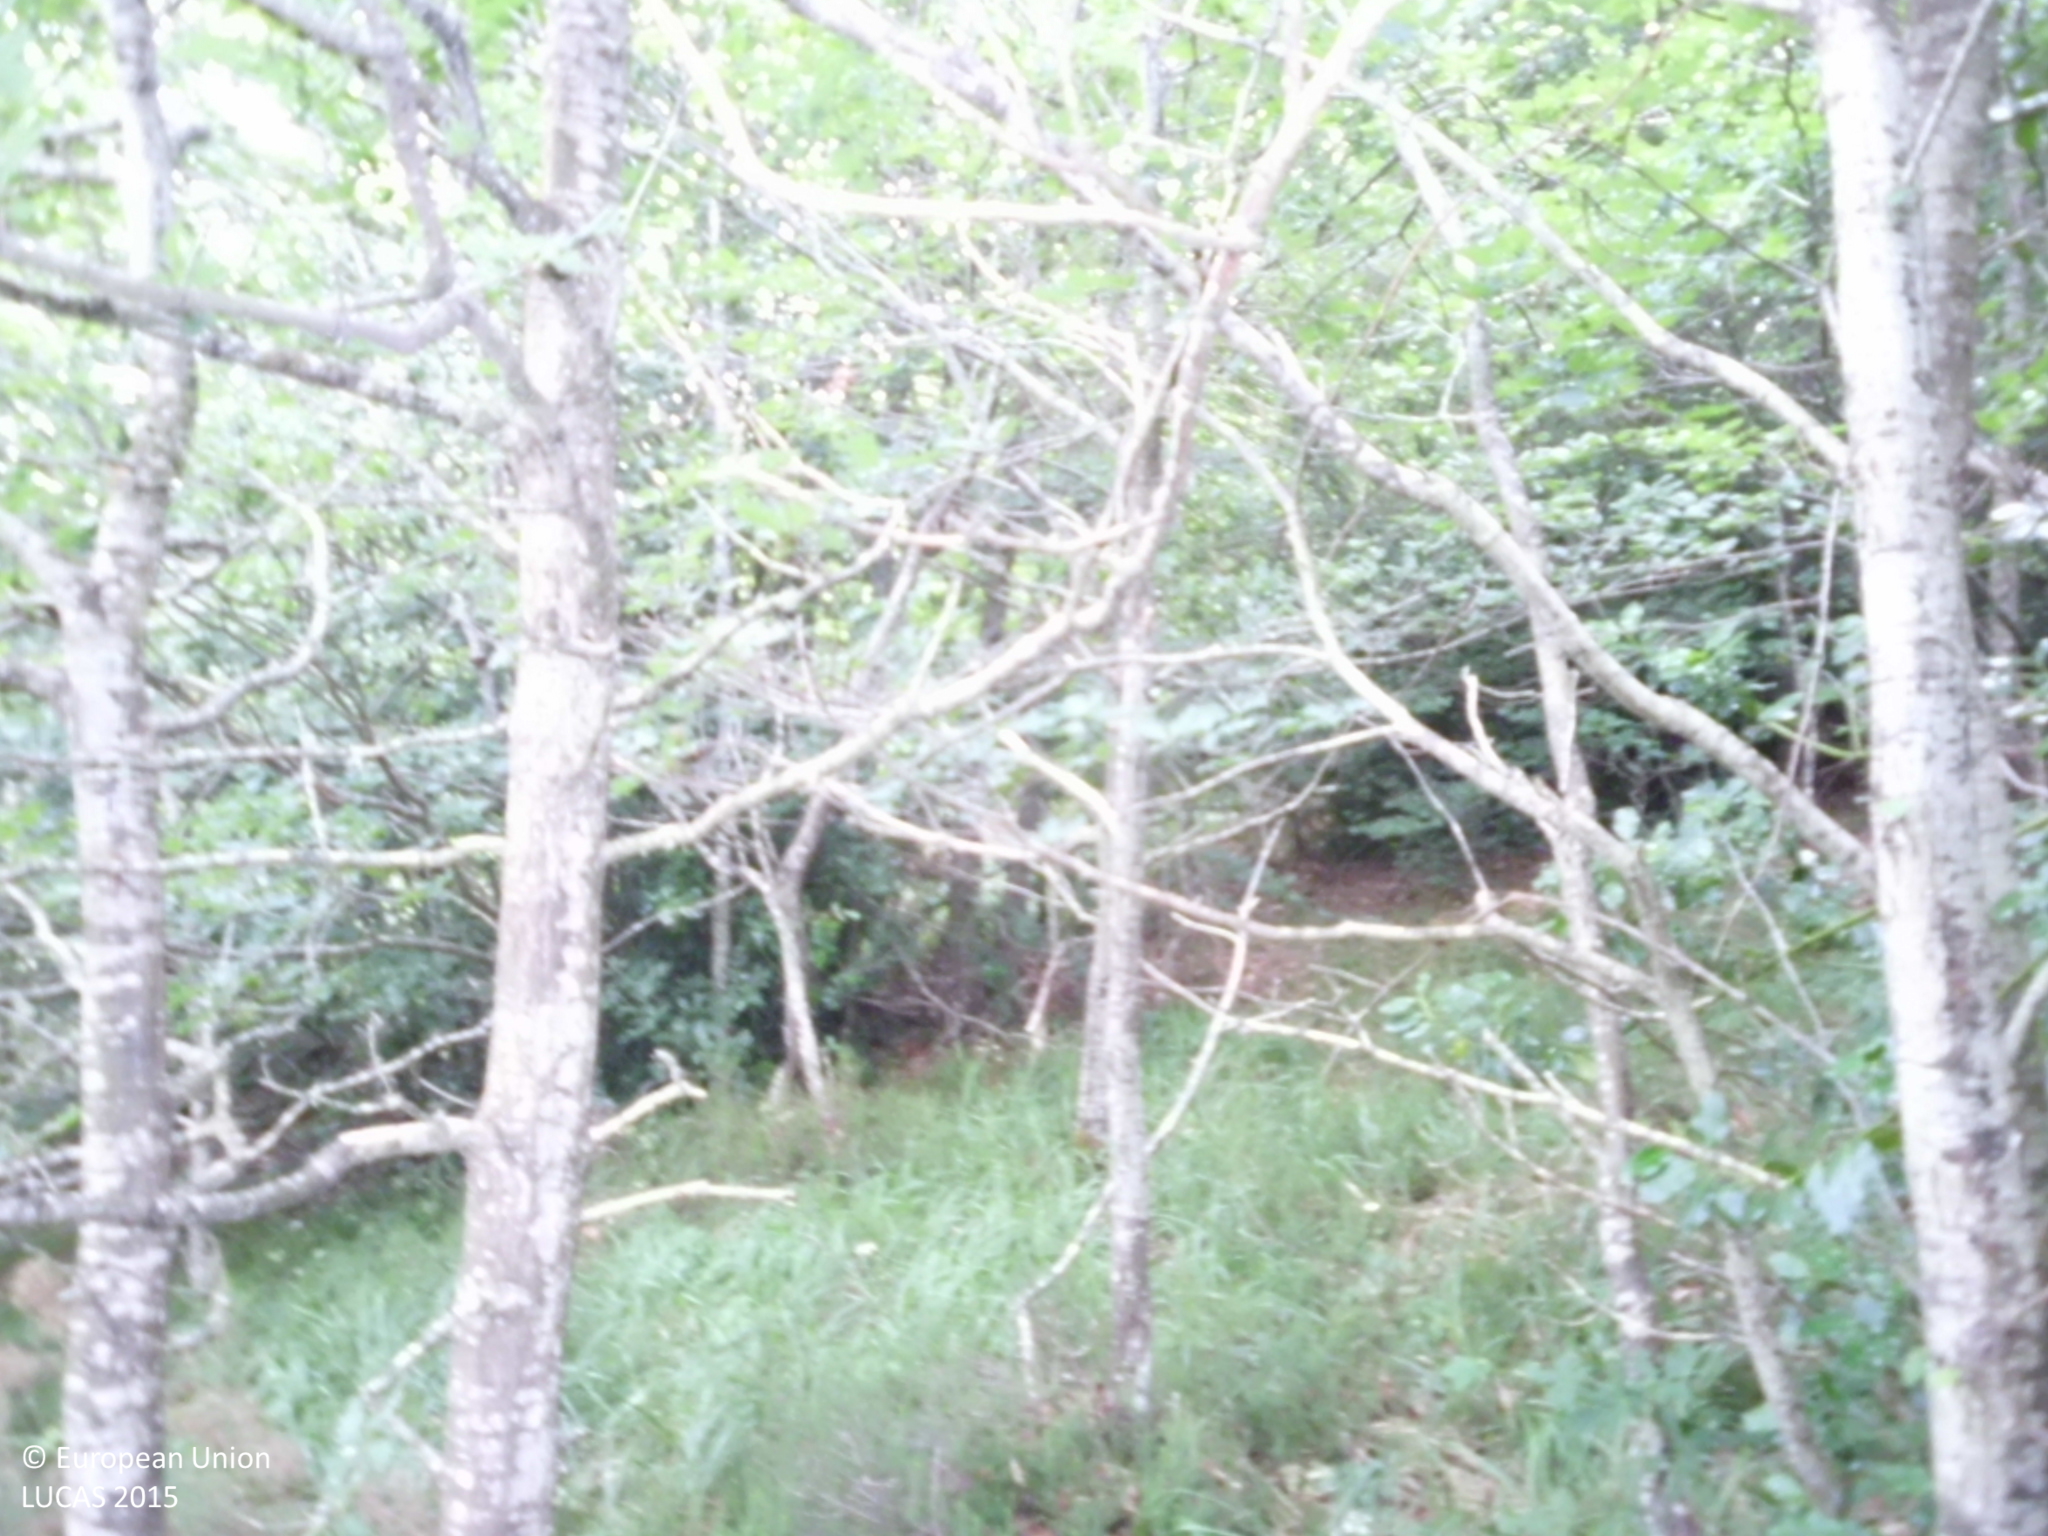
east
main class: Woodland
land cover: Broadleaved woodland
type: acidophilous oak and oak-birch forest
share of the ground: > 75 %
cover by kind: broadleaved forest trees 95 %, shrubs 5 %
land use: Semi-natural and natural areas not in use
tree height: > 5 m
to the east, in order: Broadleaved woodland
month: July
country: ES
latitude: 42.8648
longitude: -4.1369
